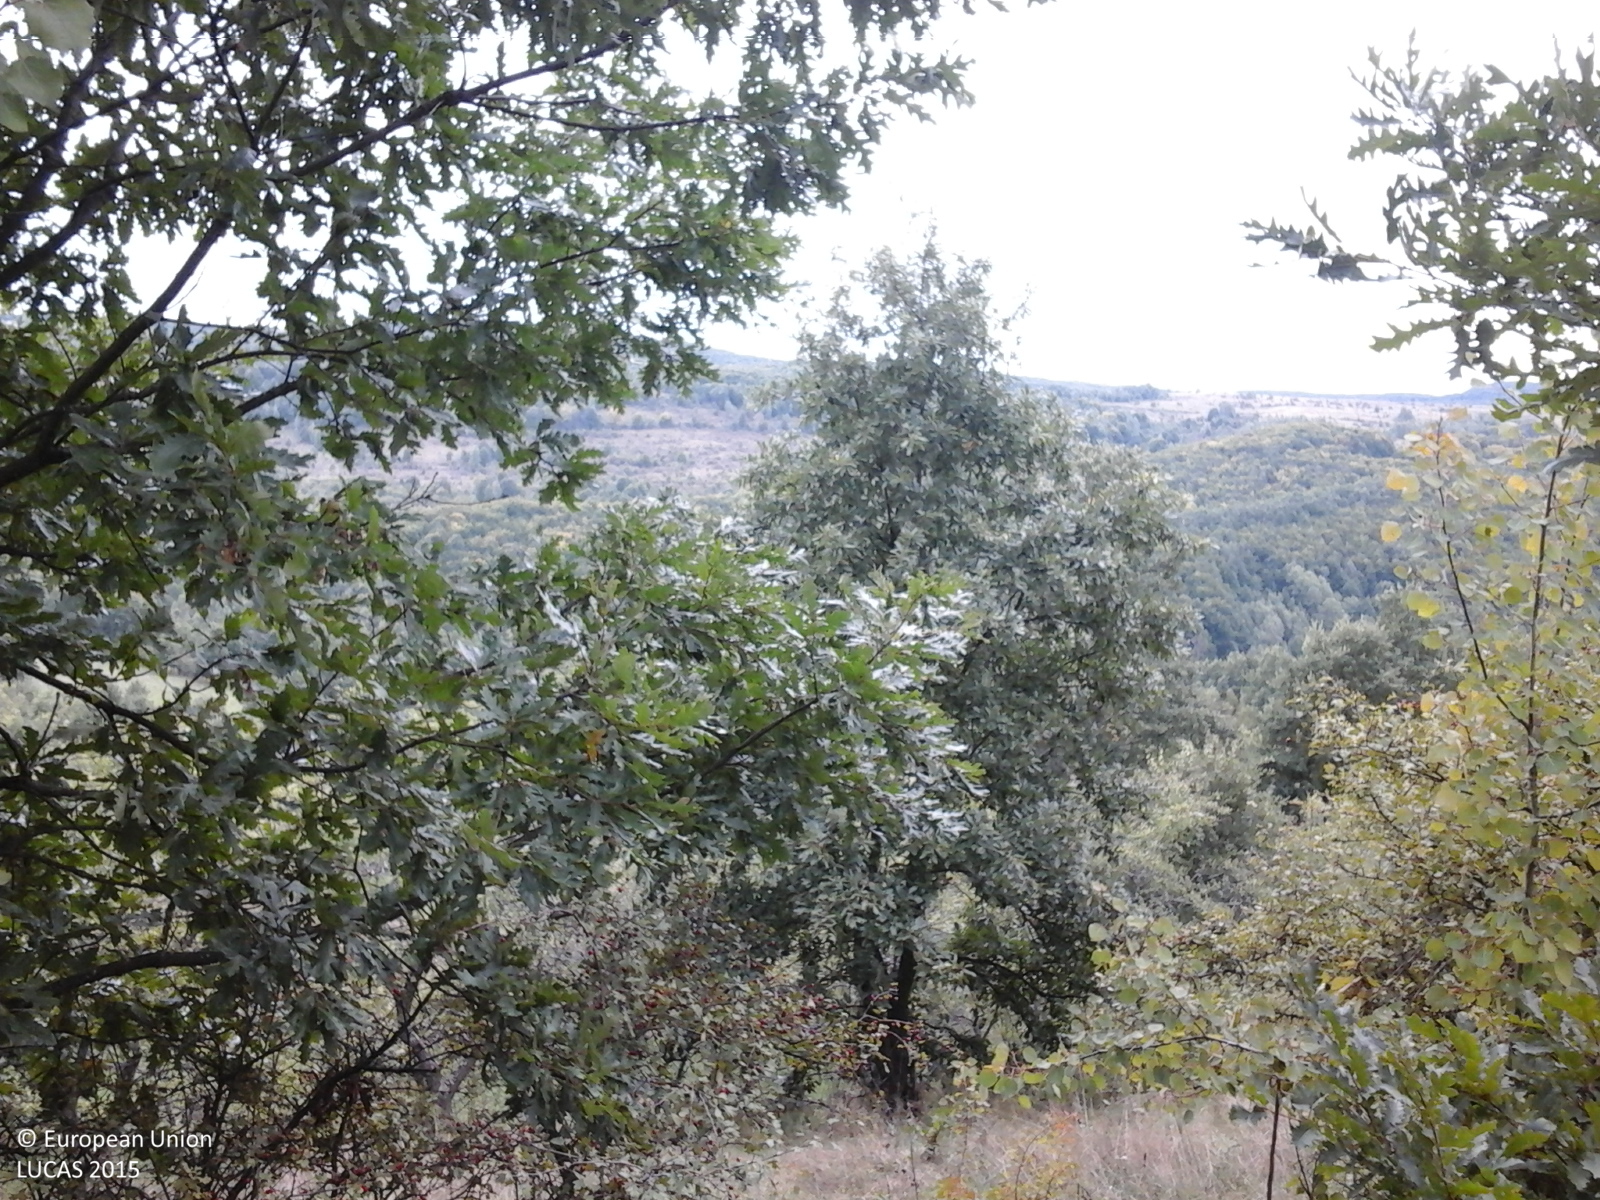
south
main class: Woodland
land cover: Broadleaved woodland
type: acidophilous oak and oak-birch forest
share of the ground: > 75 %
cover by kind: broadleaved forest trees 100 %
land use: Forestry
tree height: > 5 m
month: September
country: RO
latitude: 45.9960
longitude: 23.1114
